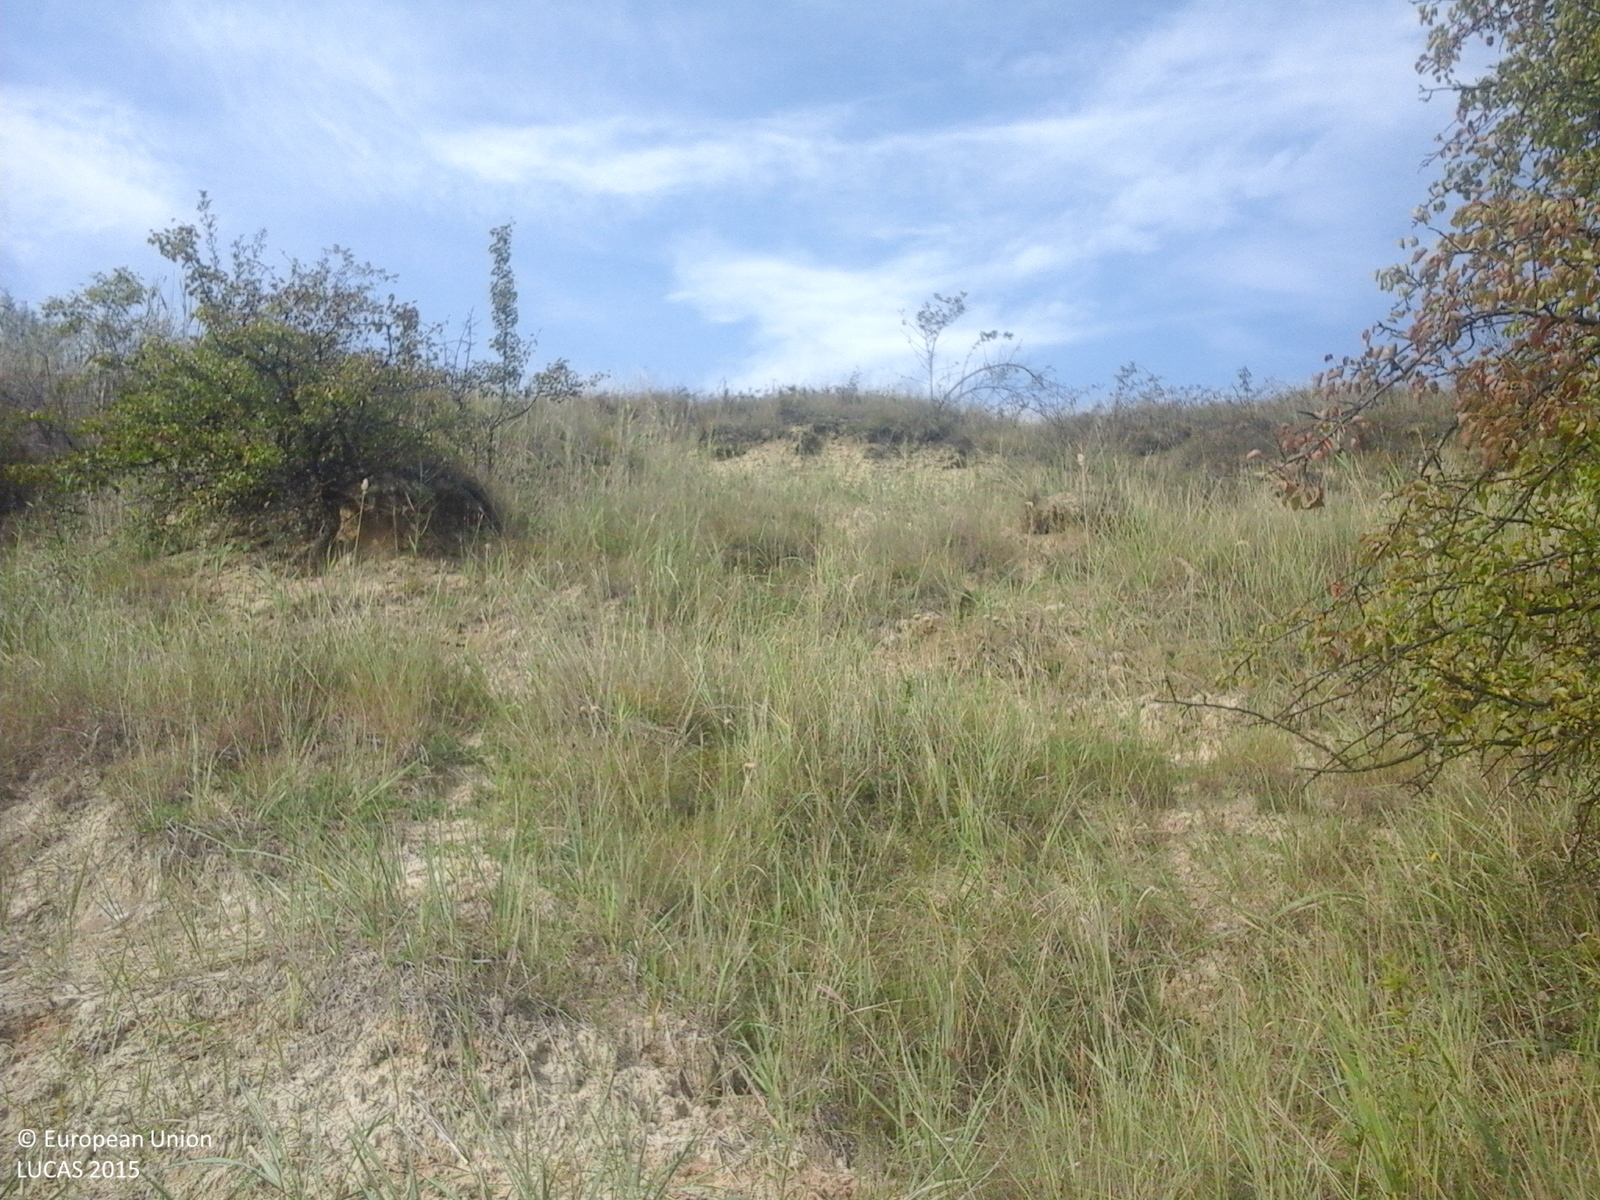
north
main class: Grassland
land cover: Grassland with sparse tree/shrub cover
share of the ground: > 75 %
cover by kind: herbaceous plants 90 %, broadleaved forest trees 5 %, shrubs 5 %
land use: Fallow land
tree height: < 5 m
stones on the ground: < 10 %
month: September
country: RO
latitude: 47.0457
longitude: 23.3225
